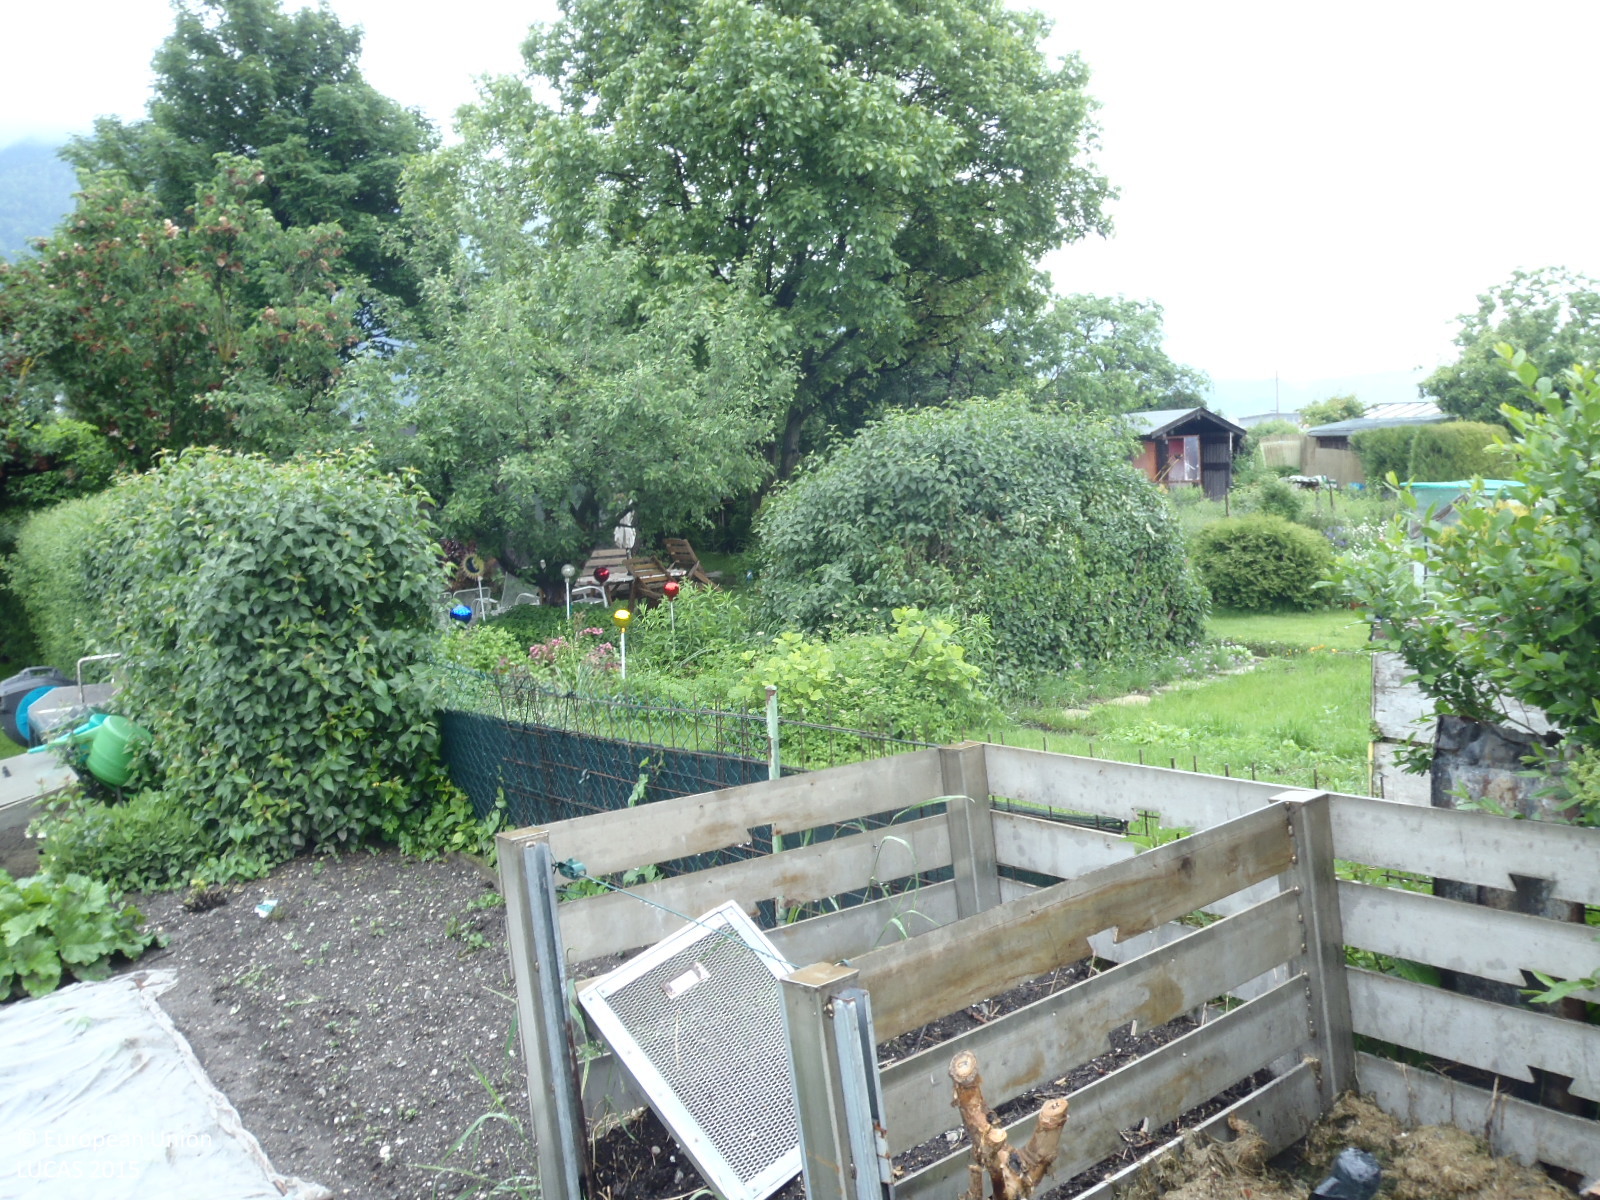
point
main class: Woodland
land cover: Broadleaved woodland
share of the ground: > 75 %
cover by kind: broadleaved forest trees 95 %, shrubs 5 %
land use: Residential
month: May
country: AT
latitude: 47.2777
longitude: 11.4661
